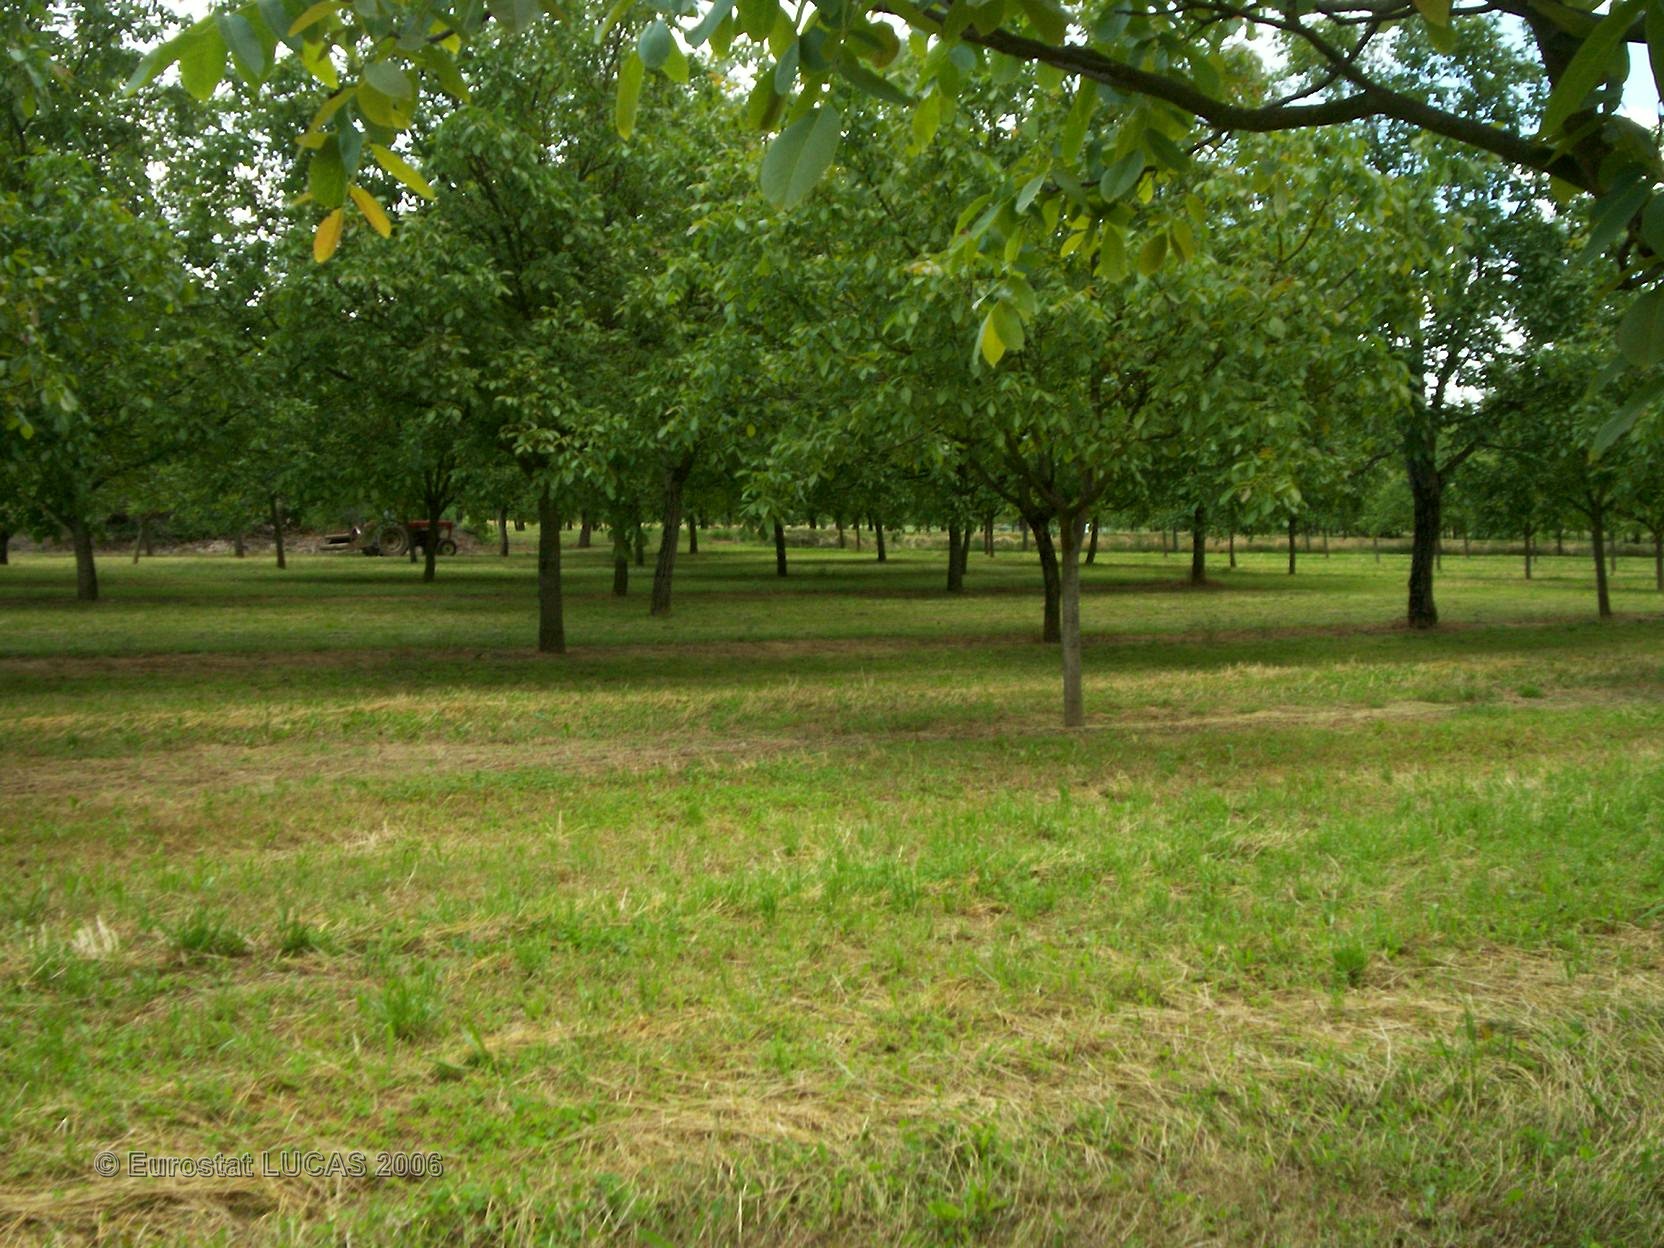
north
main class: Cropland
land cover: Nuts trees
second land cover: Grassland with sparse tree/shrub cover
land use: Agriculture (excluding fallow land and kitchen gardens)
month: June
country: FR
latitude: 45.2071
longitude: 5.4346
